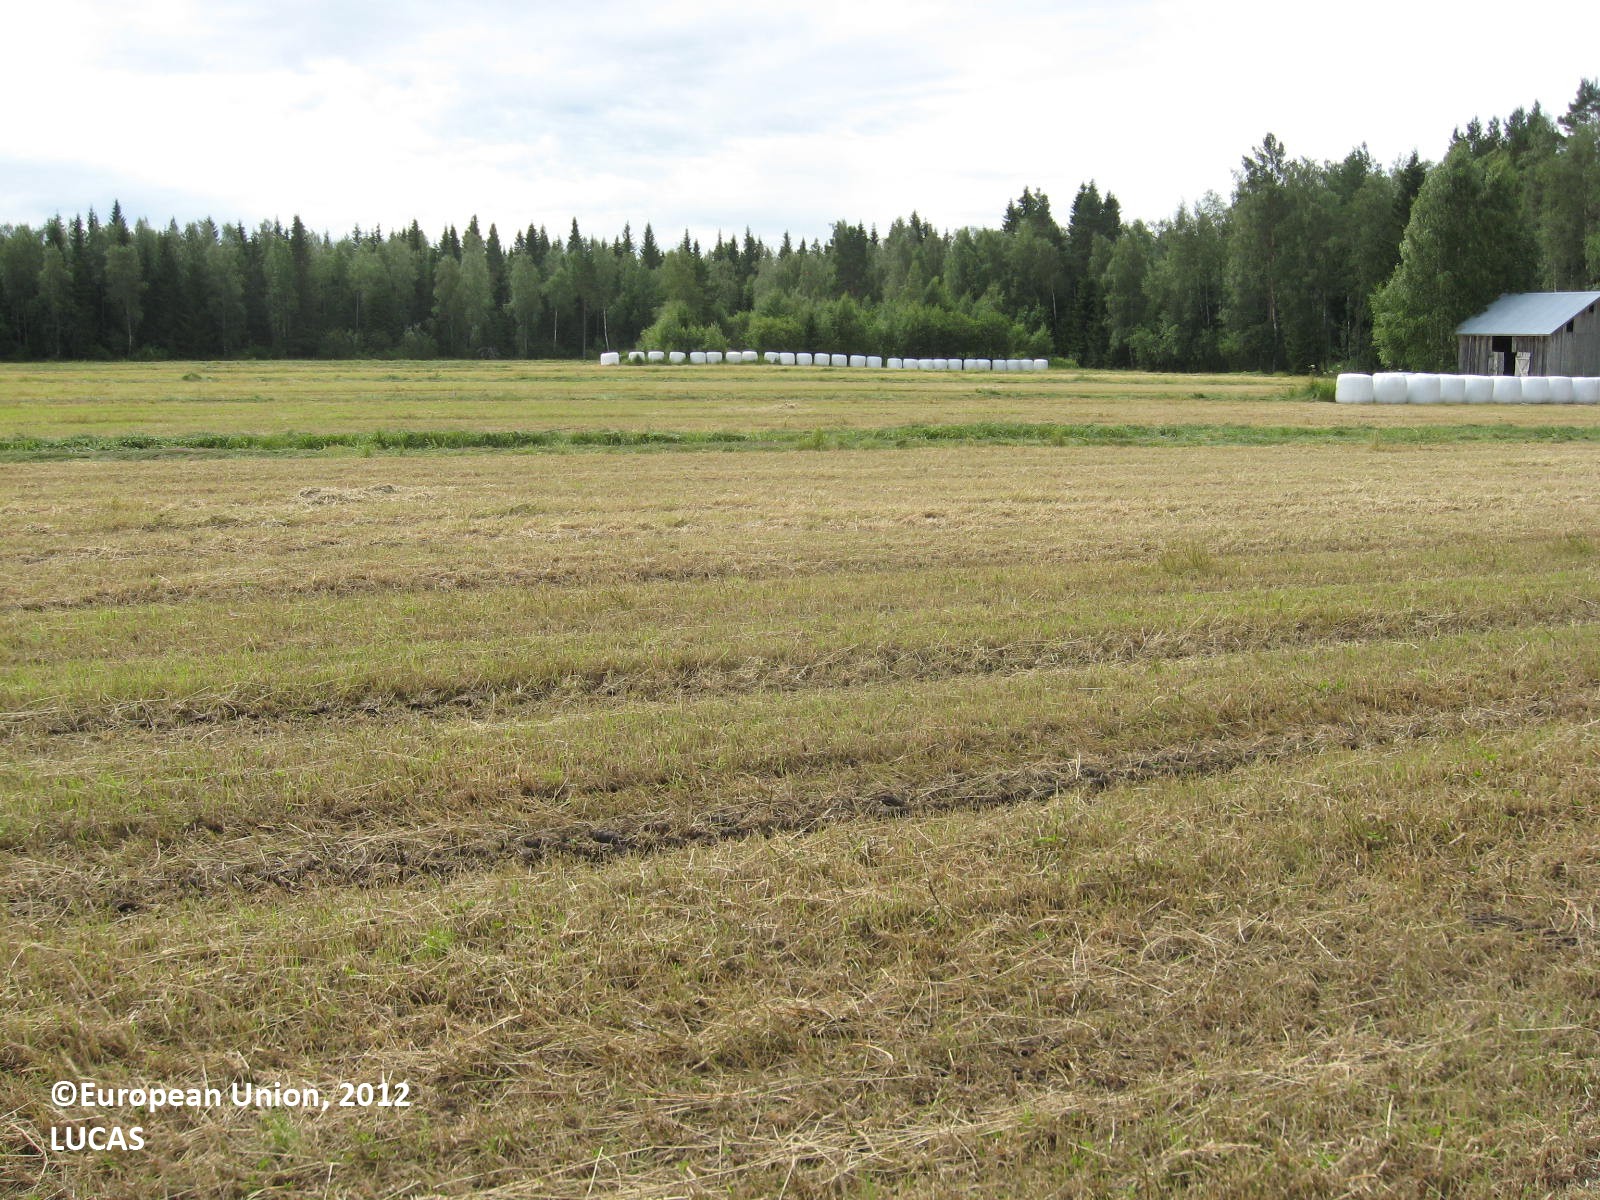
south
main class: Cropland
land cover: Temporary grasslands
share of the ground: > 75 %
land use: Agriculture (excluding fallow land and kitchen gardens)
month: July
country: FI
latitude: 61.9864
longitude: 21.5175
